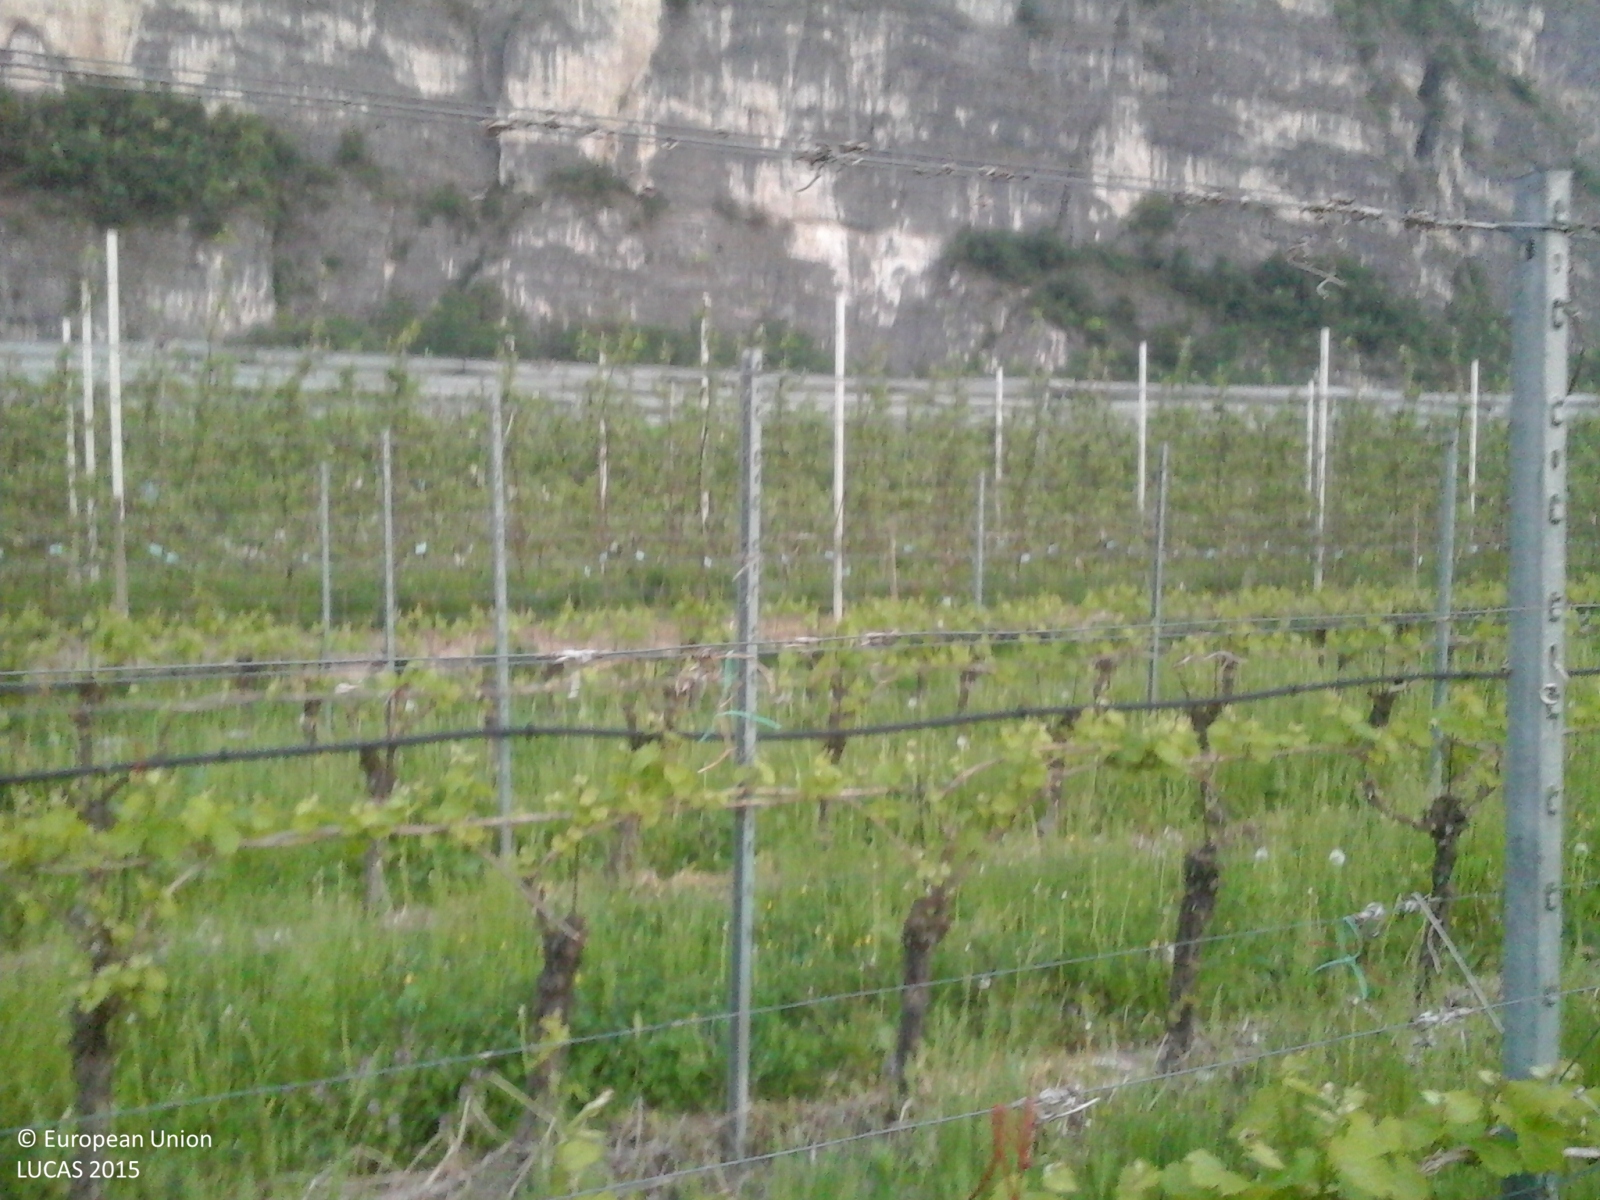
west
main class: Cropland
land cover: Vineyards
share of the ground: < 10 %
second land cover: Grassland without tree/shrub cover
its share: > 75 %
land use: Agriculture (excluding fallow land and kitchen gardens)
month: April
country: IT
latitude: 46.1477
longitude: 11.0731
